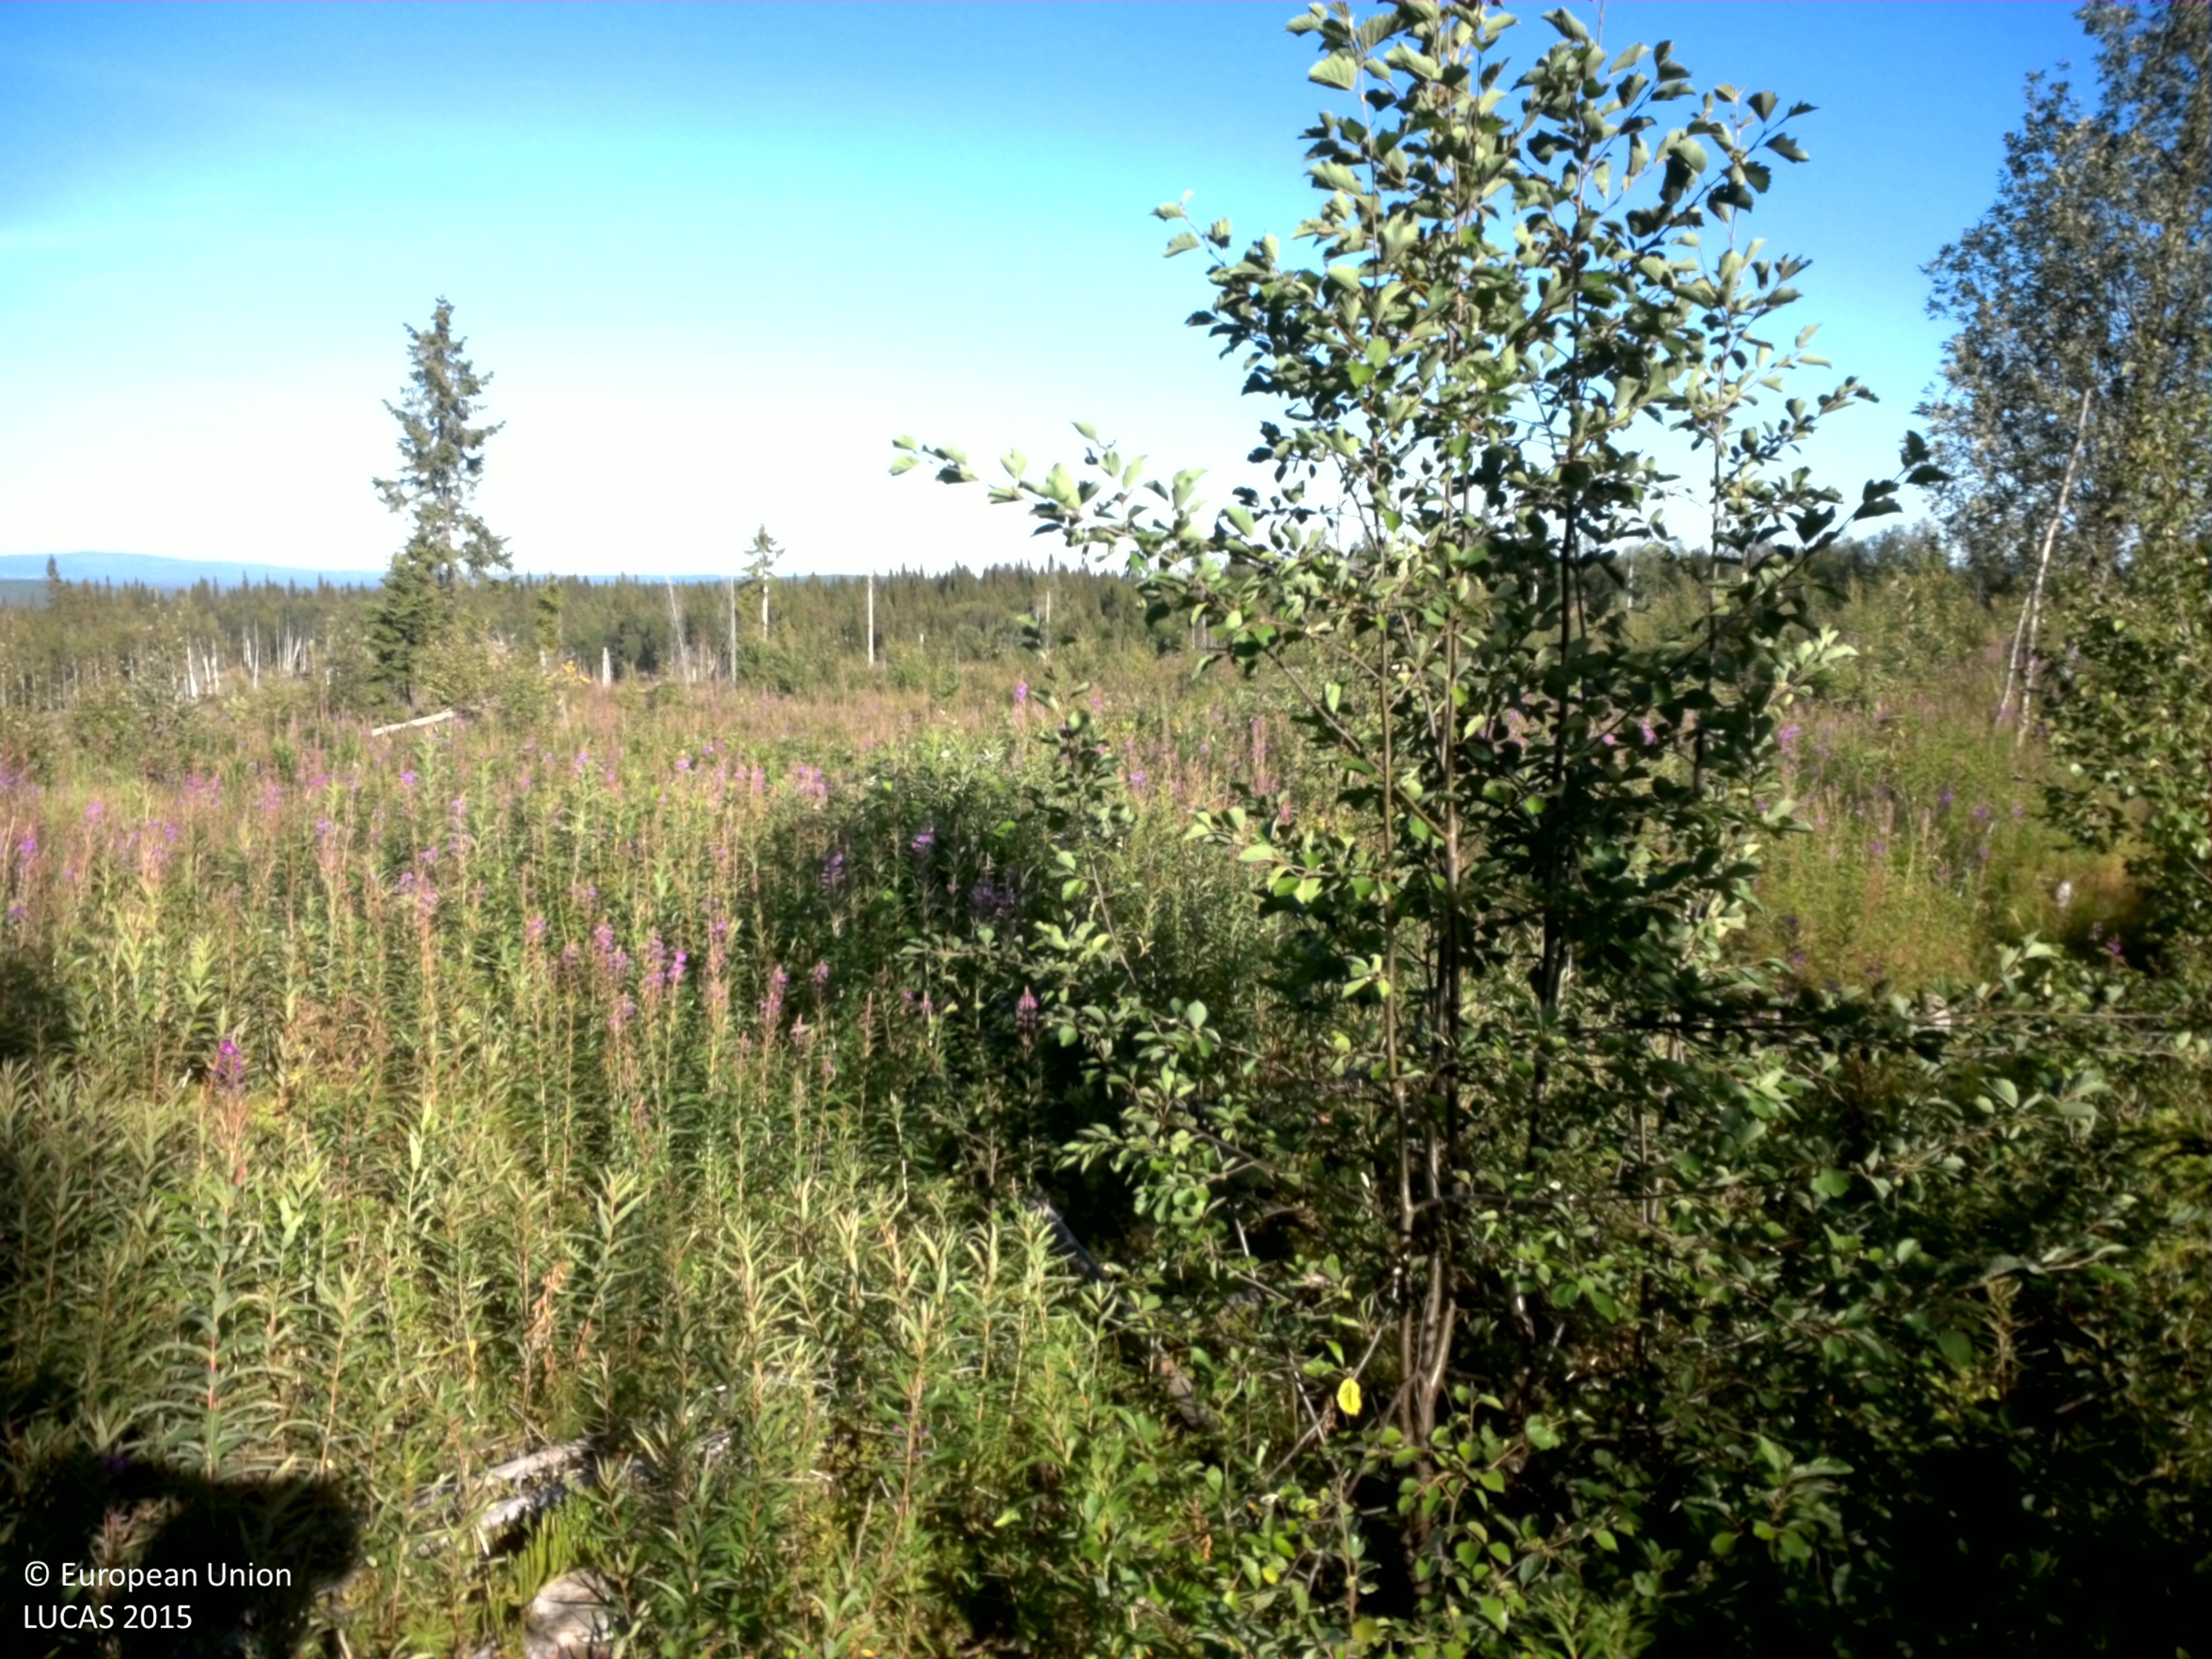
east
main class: Woodland
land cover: Spruce dominated mixed woodland
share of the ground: 10 - 25 %
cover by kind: herbaceous plants 75 %, broadleaved forest trees 10 %, shrubs 10 %, coniferous forest trees 5 %
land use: Forestry
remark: Clear cut
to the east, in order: Spruce dominated mixed woodland; Ditches and canals; Shrubland with sparse tree cover; Grassland without tree/shrub cover; Ditches and canals; Paved roads, cycling and walking lanes; Ditches and canals; Grassland with sparse tree/shrub cover; Ditches and canals; Broadleaved woodland
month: August
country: SE
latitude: 64.6972
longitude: 16.1115
